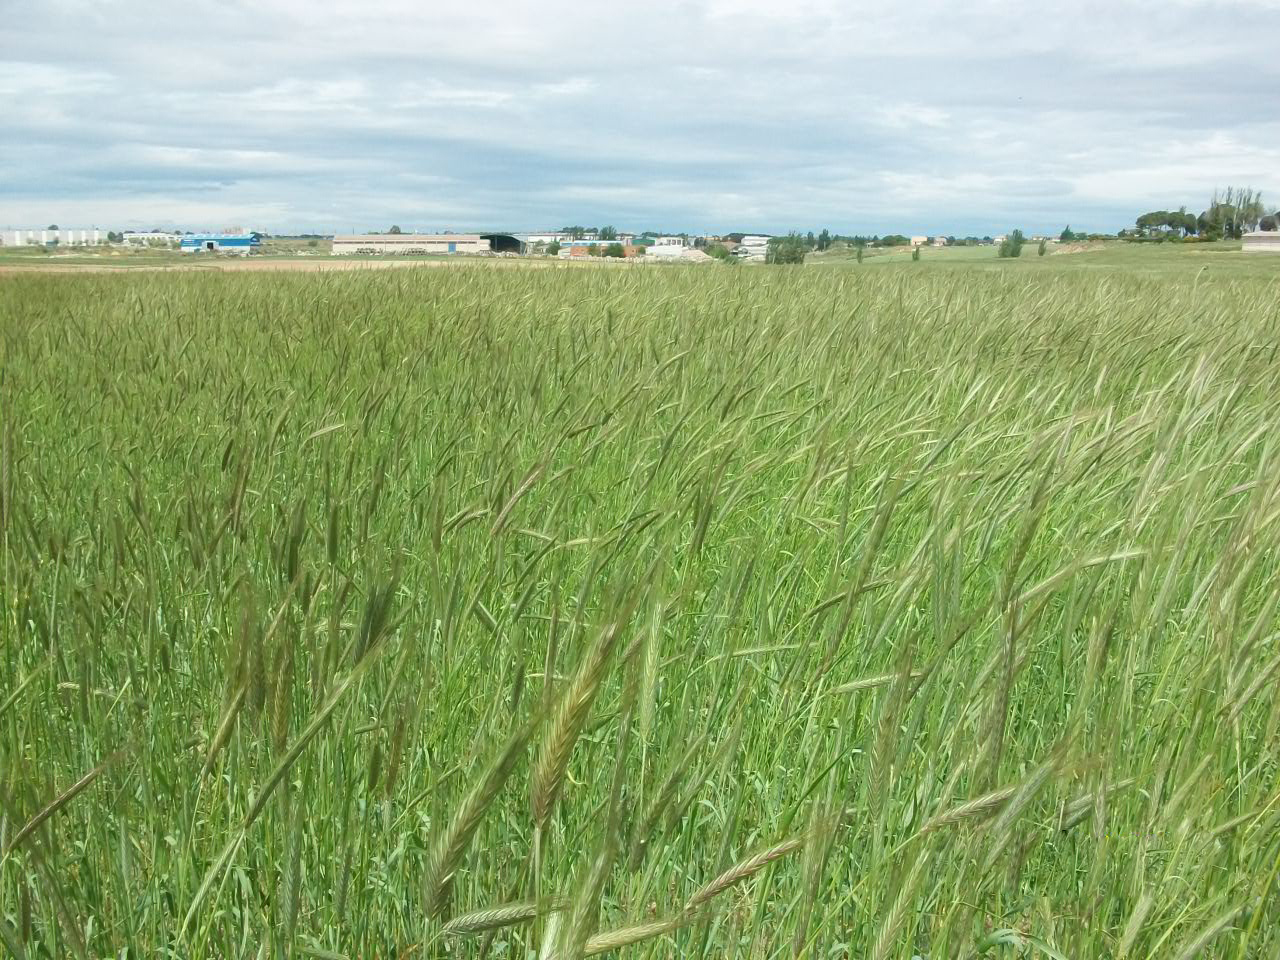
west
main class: Cropland
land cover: Rye
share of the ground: > 75 %
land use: Agriculture (excluding fallow land and kitchen gardens)
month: May
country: ES
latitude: 40.2008
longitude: -3.8163
